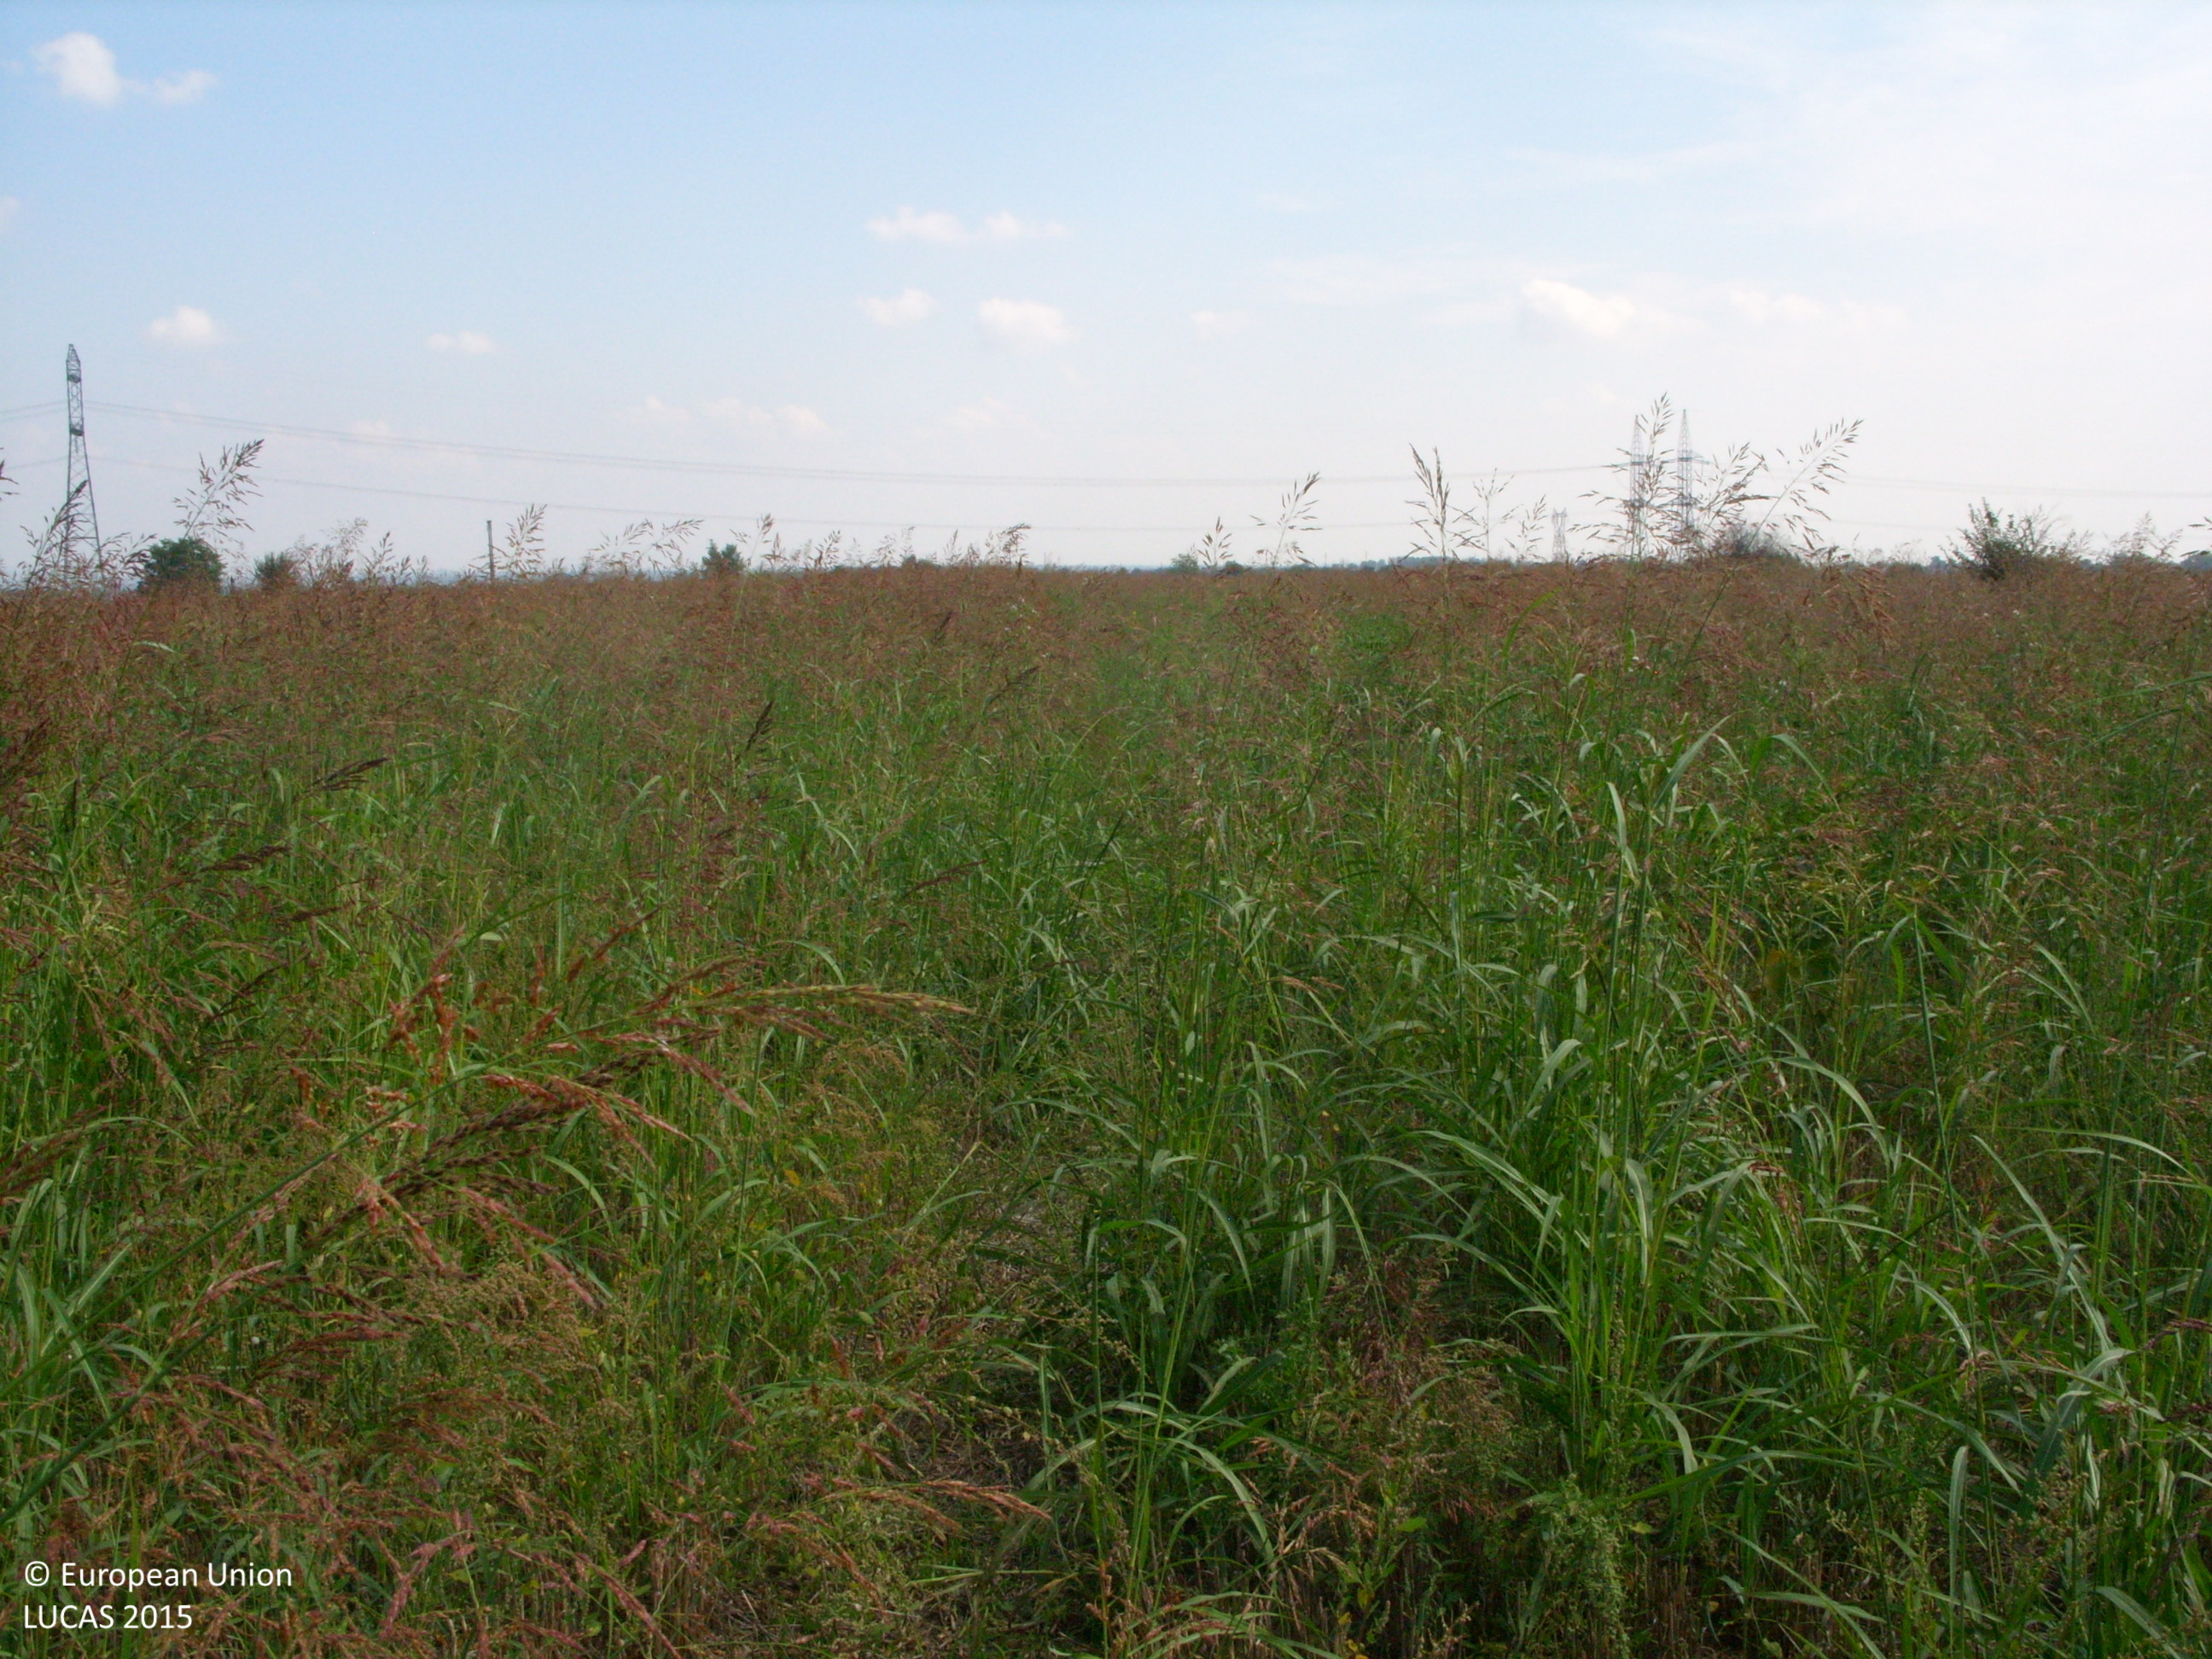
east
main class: Grassland
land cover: Spontaneously vegetated surfaces
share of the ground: > 75 %
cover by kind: herbaceous plants 100 %
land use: Fallow land
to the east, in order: Spontaneously vegetated surfaces; Tracks; Spontaneously vegetated surfaces; Ditches and canals; Maize
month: September
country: BG
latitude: 42.3899
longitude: 24.7648
